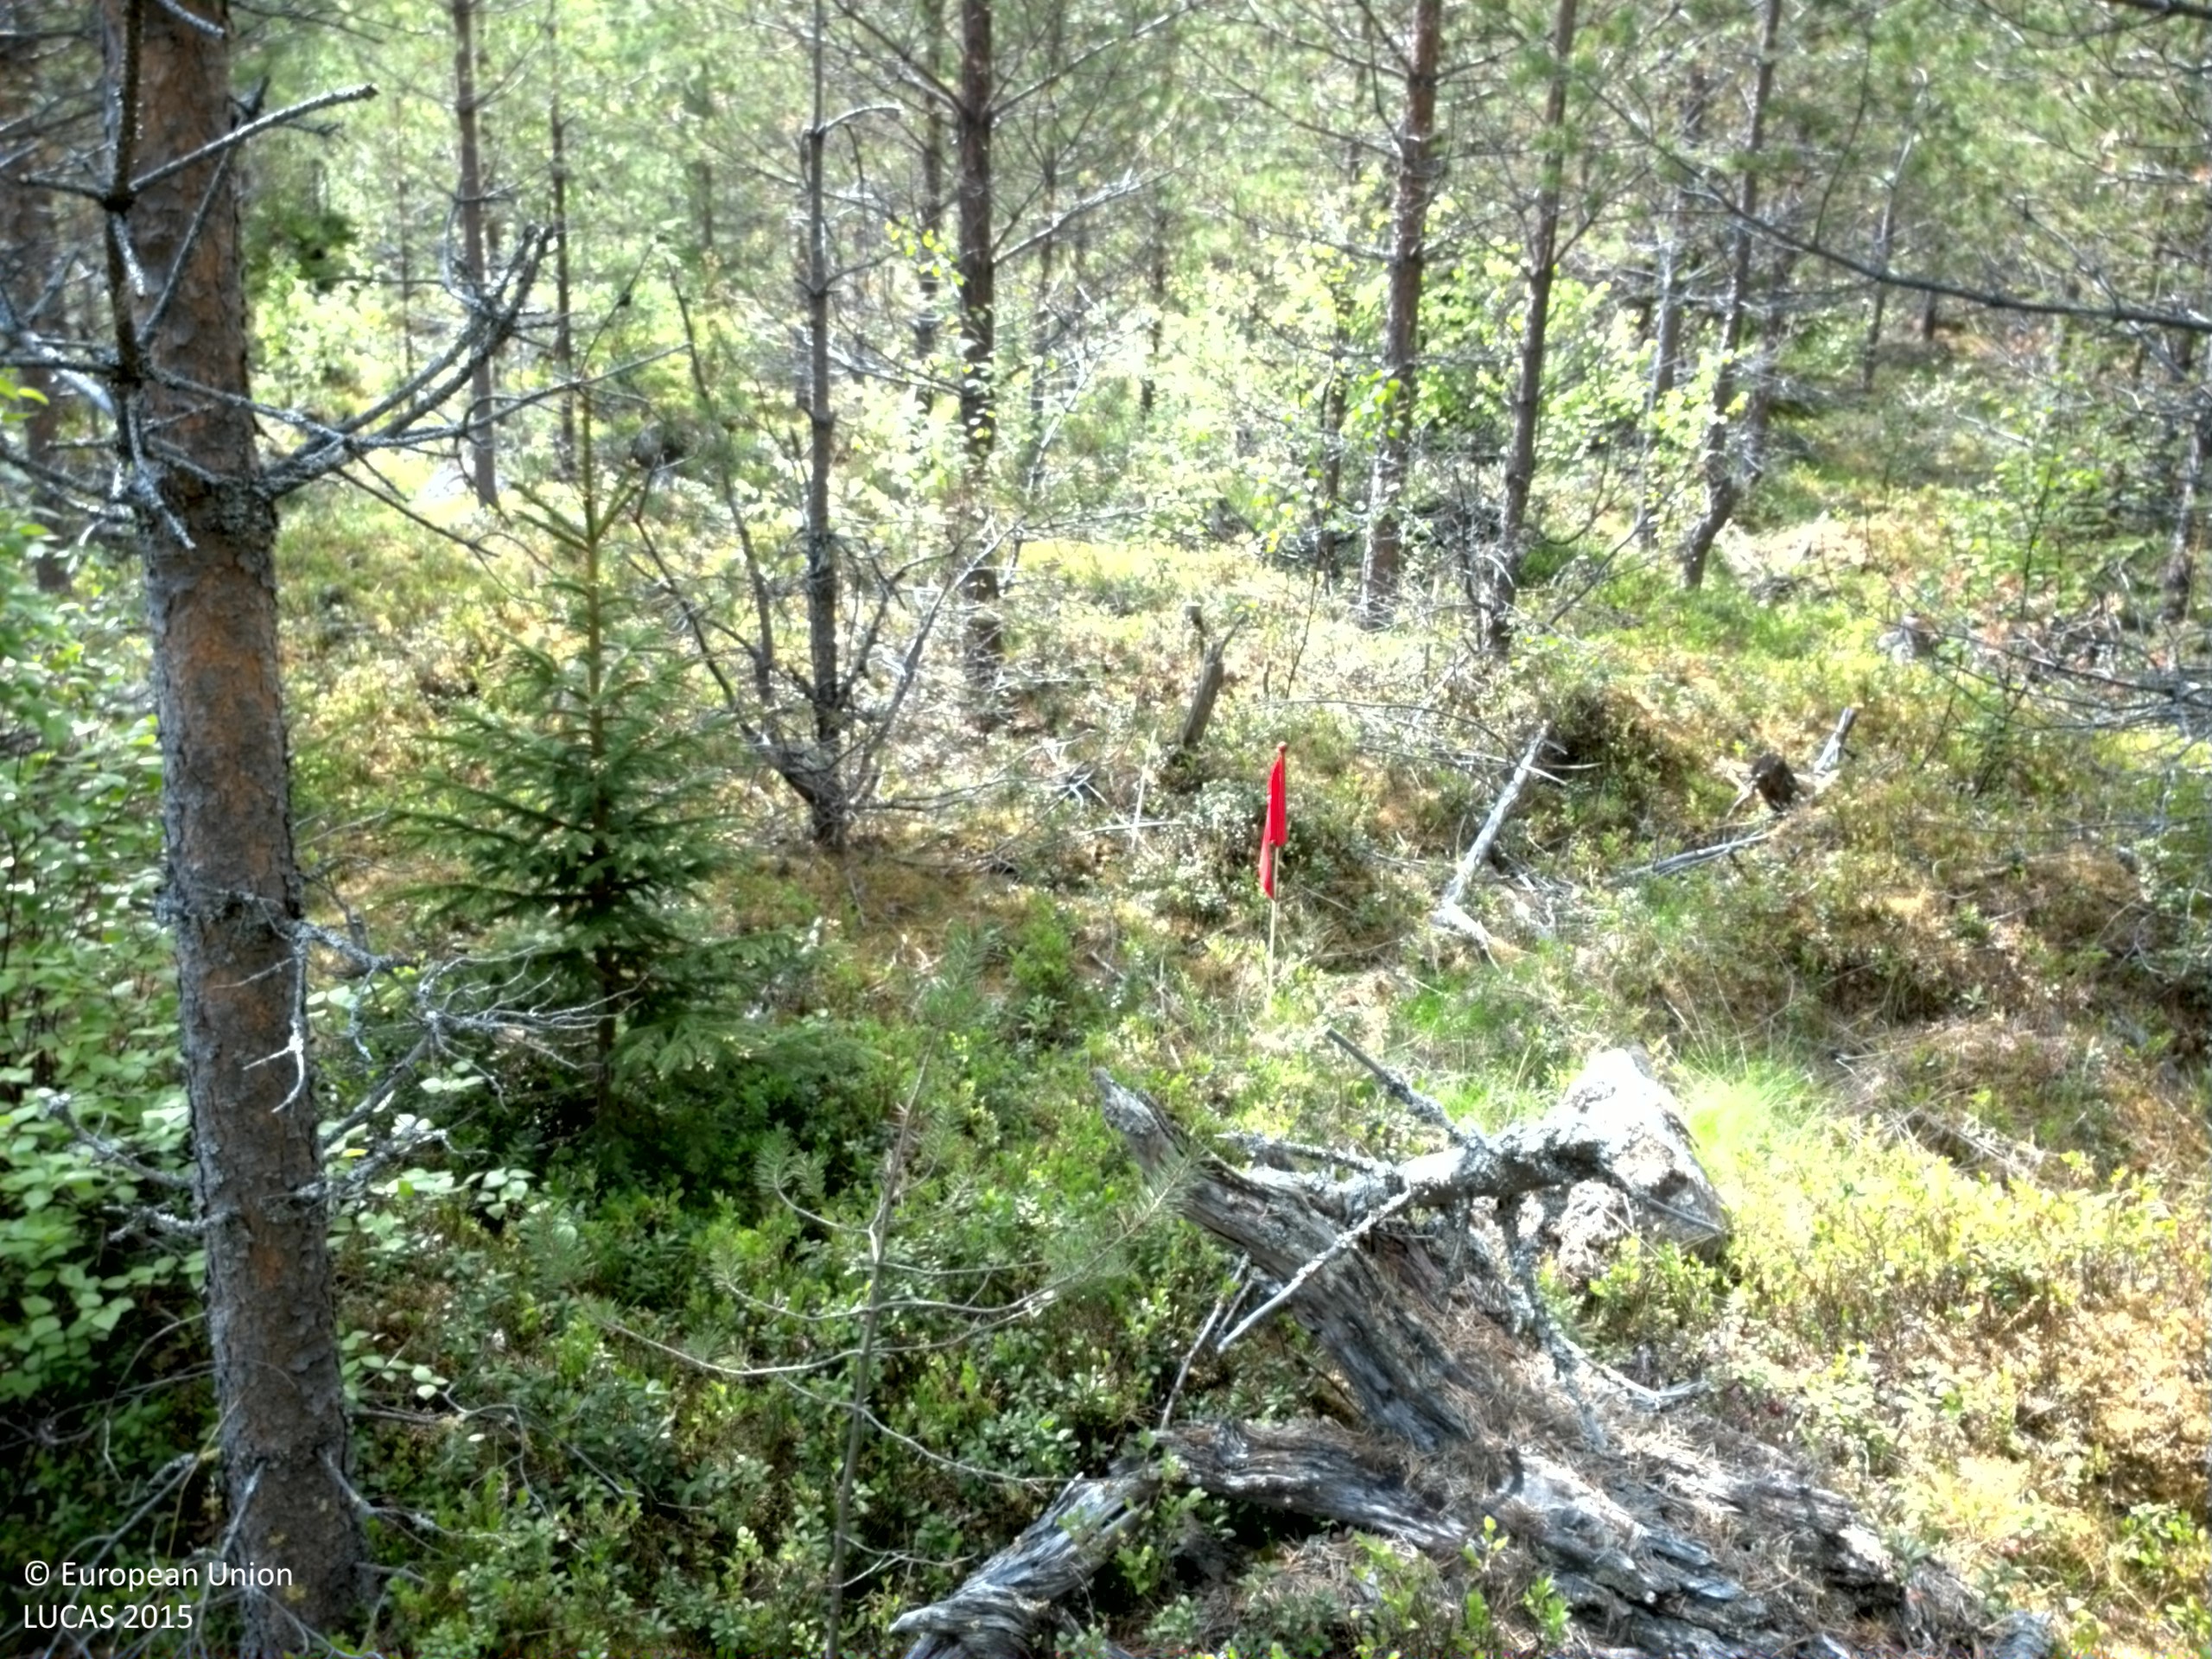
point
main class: Woodland
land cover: Pine dominated coniferous woodland
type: boreal forest
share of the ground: > 75 %
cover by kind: coniferous forest trees 85 %, shrubs 15 %
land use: Forestry
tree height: > 5 m
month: June
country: SE
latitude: 62.9757
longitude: 16.9799
